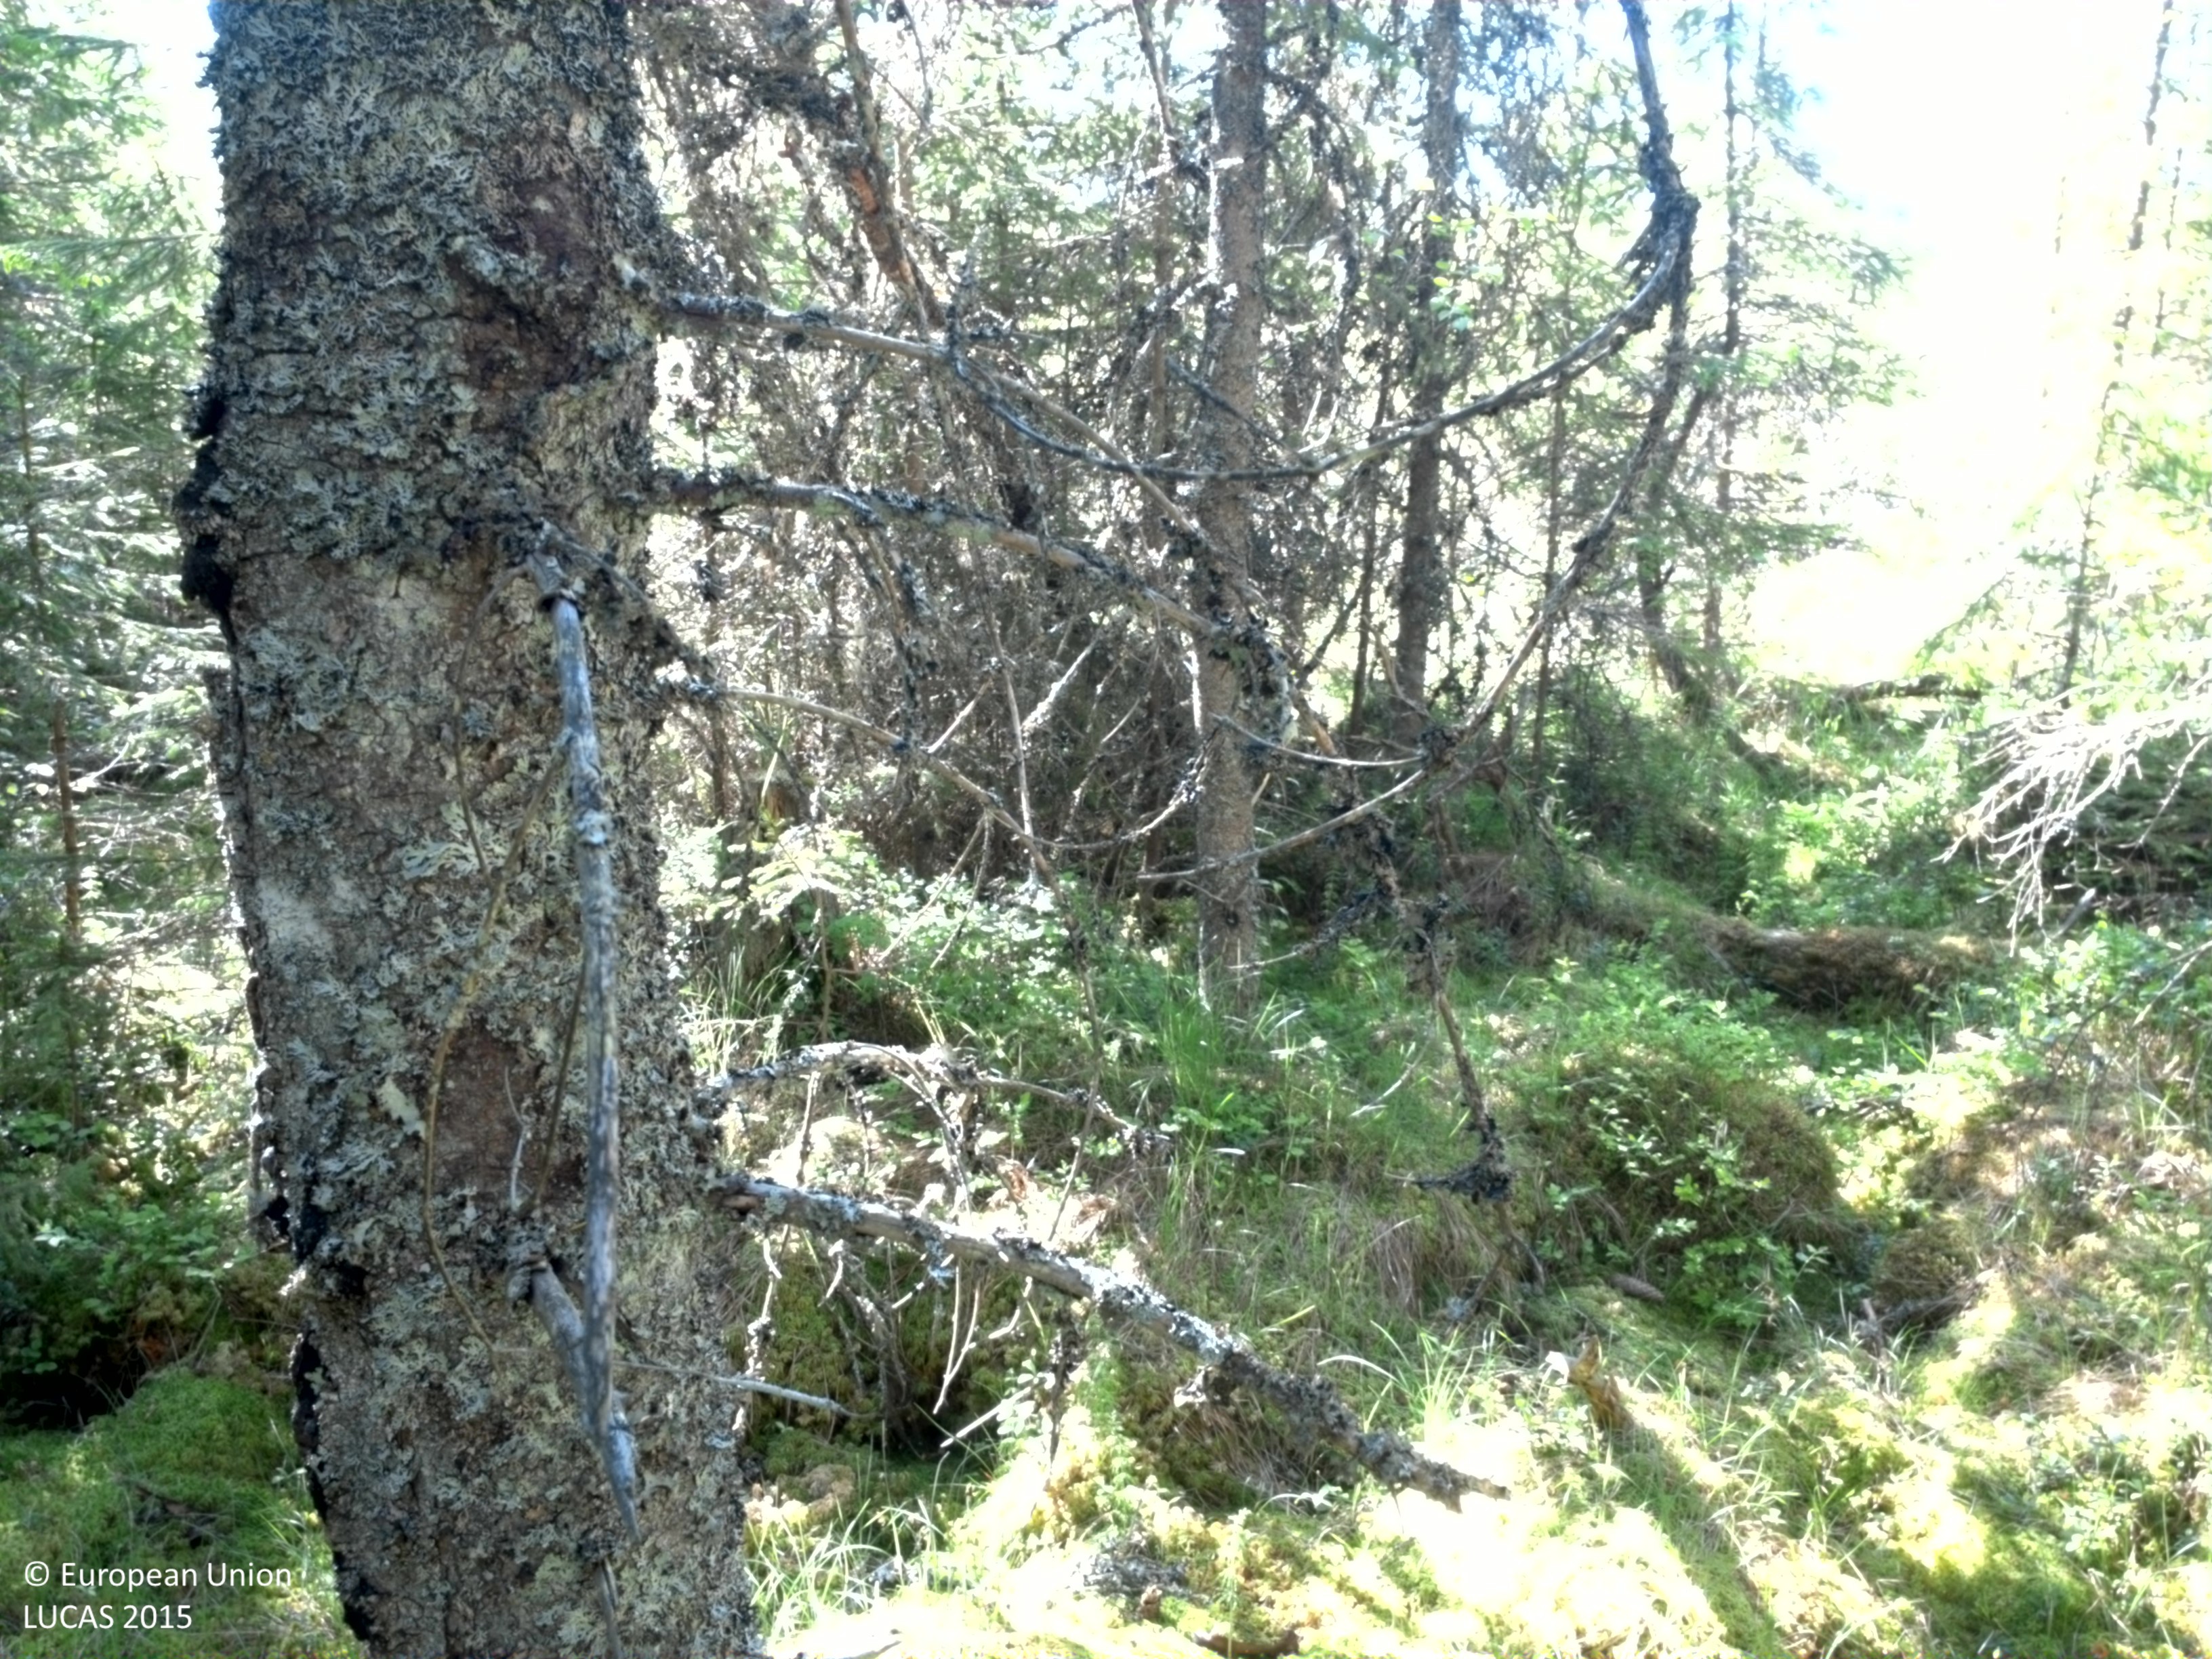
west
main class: Woodland
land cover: Spruce dominated coniferous woodland
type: boreal forest
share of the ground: 50 - 75 %
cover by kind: coniferous forest trees 65 %, shrubs 15 %, herbaceous plants 10 %, broadleaved forest trees 5 %, lichens and mosses 5 %
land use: Forestry
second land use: Community services
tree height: > 5 m
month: June
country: SE
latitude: 59.3096
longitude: 14.6814
